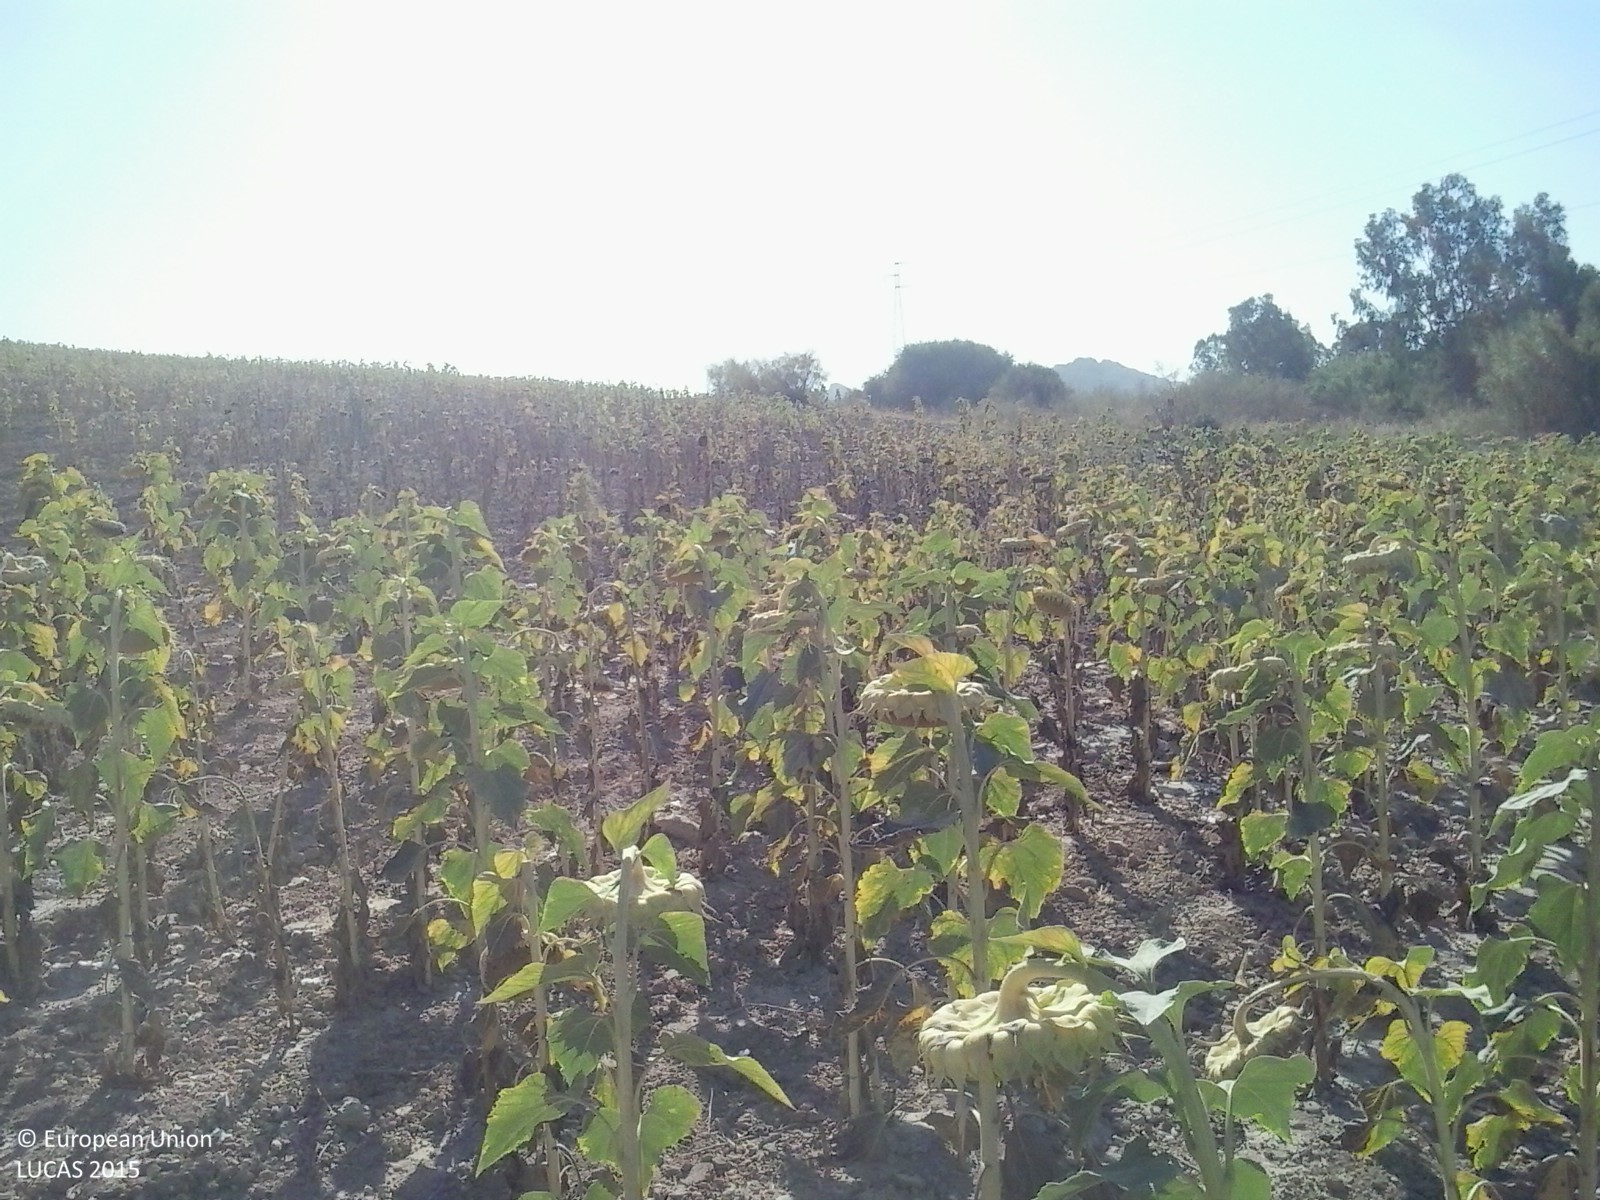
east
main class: Cropland
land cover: Sunflower
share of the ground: 10 - 25 %
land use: Agriculture (excluding fallow land and kitchen gardens)
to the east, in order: Sunflower; Grass margins; Tracks; Single bushes/trees; Grassland without tree/shrub cover; Rivers and streams; Other bare soil
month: July
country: ES
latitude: 36.8670
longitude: -5.9758
